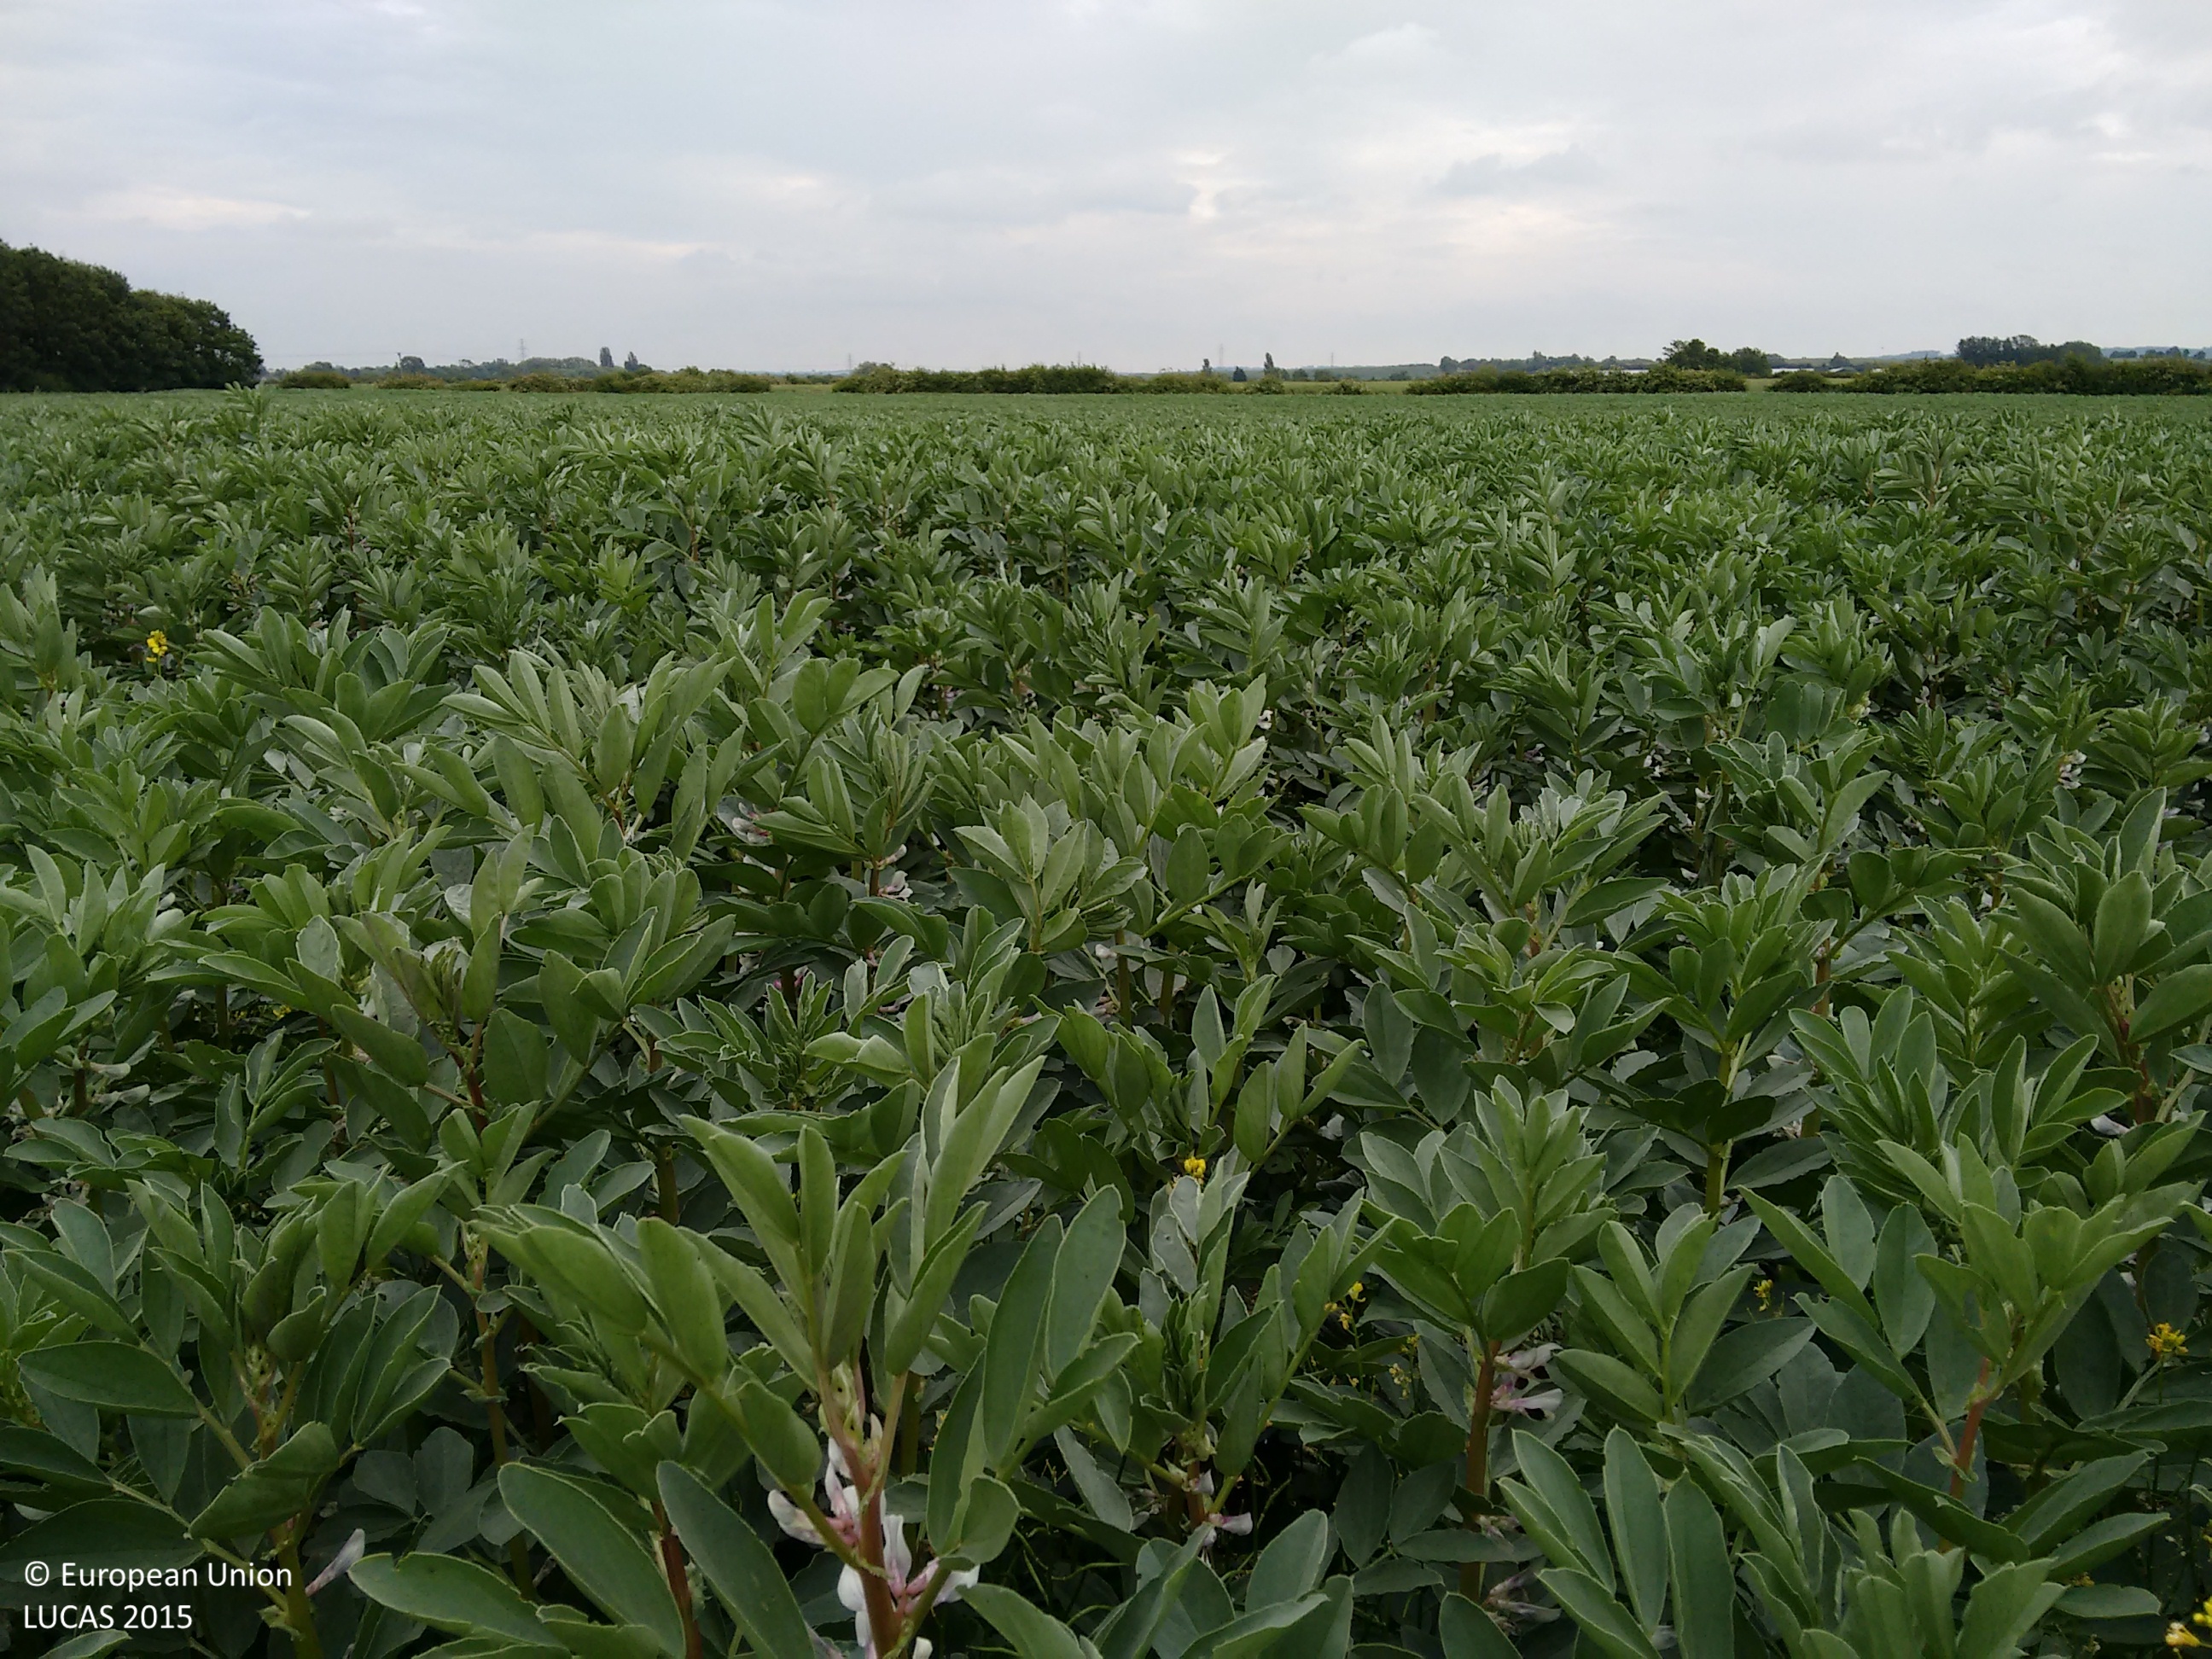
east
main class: Cropland
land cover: Dry pulses
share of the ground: > 75 %
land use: Agriculture (excluding fallow land and kitchen gardens)
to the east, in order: Dry pulses; Tracks; Grass margins; Ditches and canals; Managed hedges; Grassland without tree/shrub cover; Ditches and canals
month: June
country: GB
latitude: 52.9330
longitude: -0.8280
